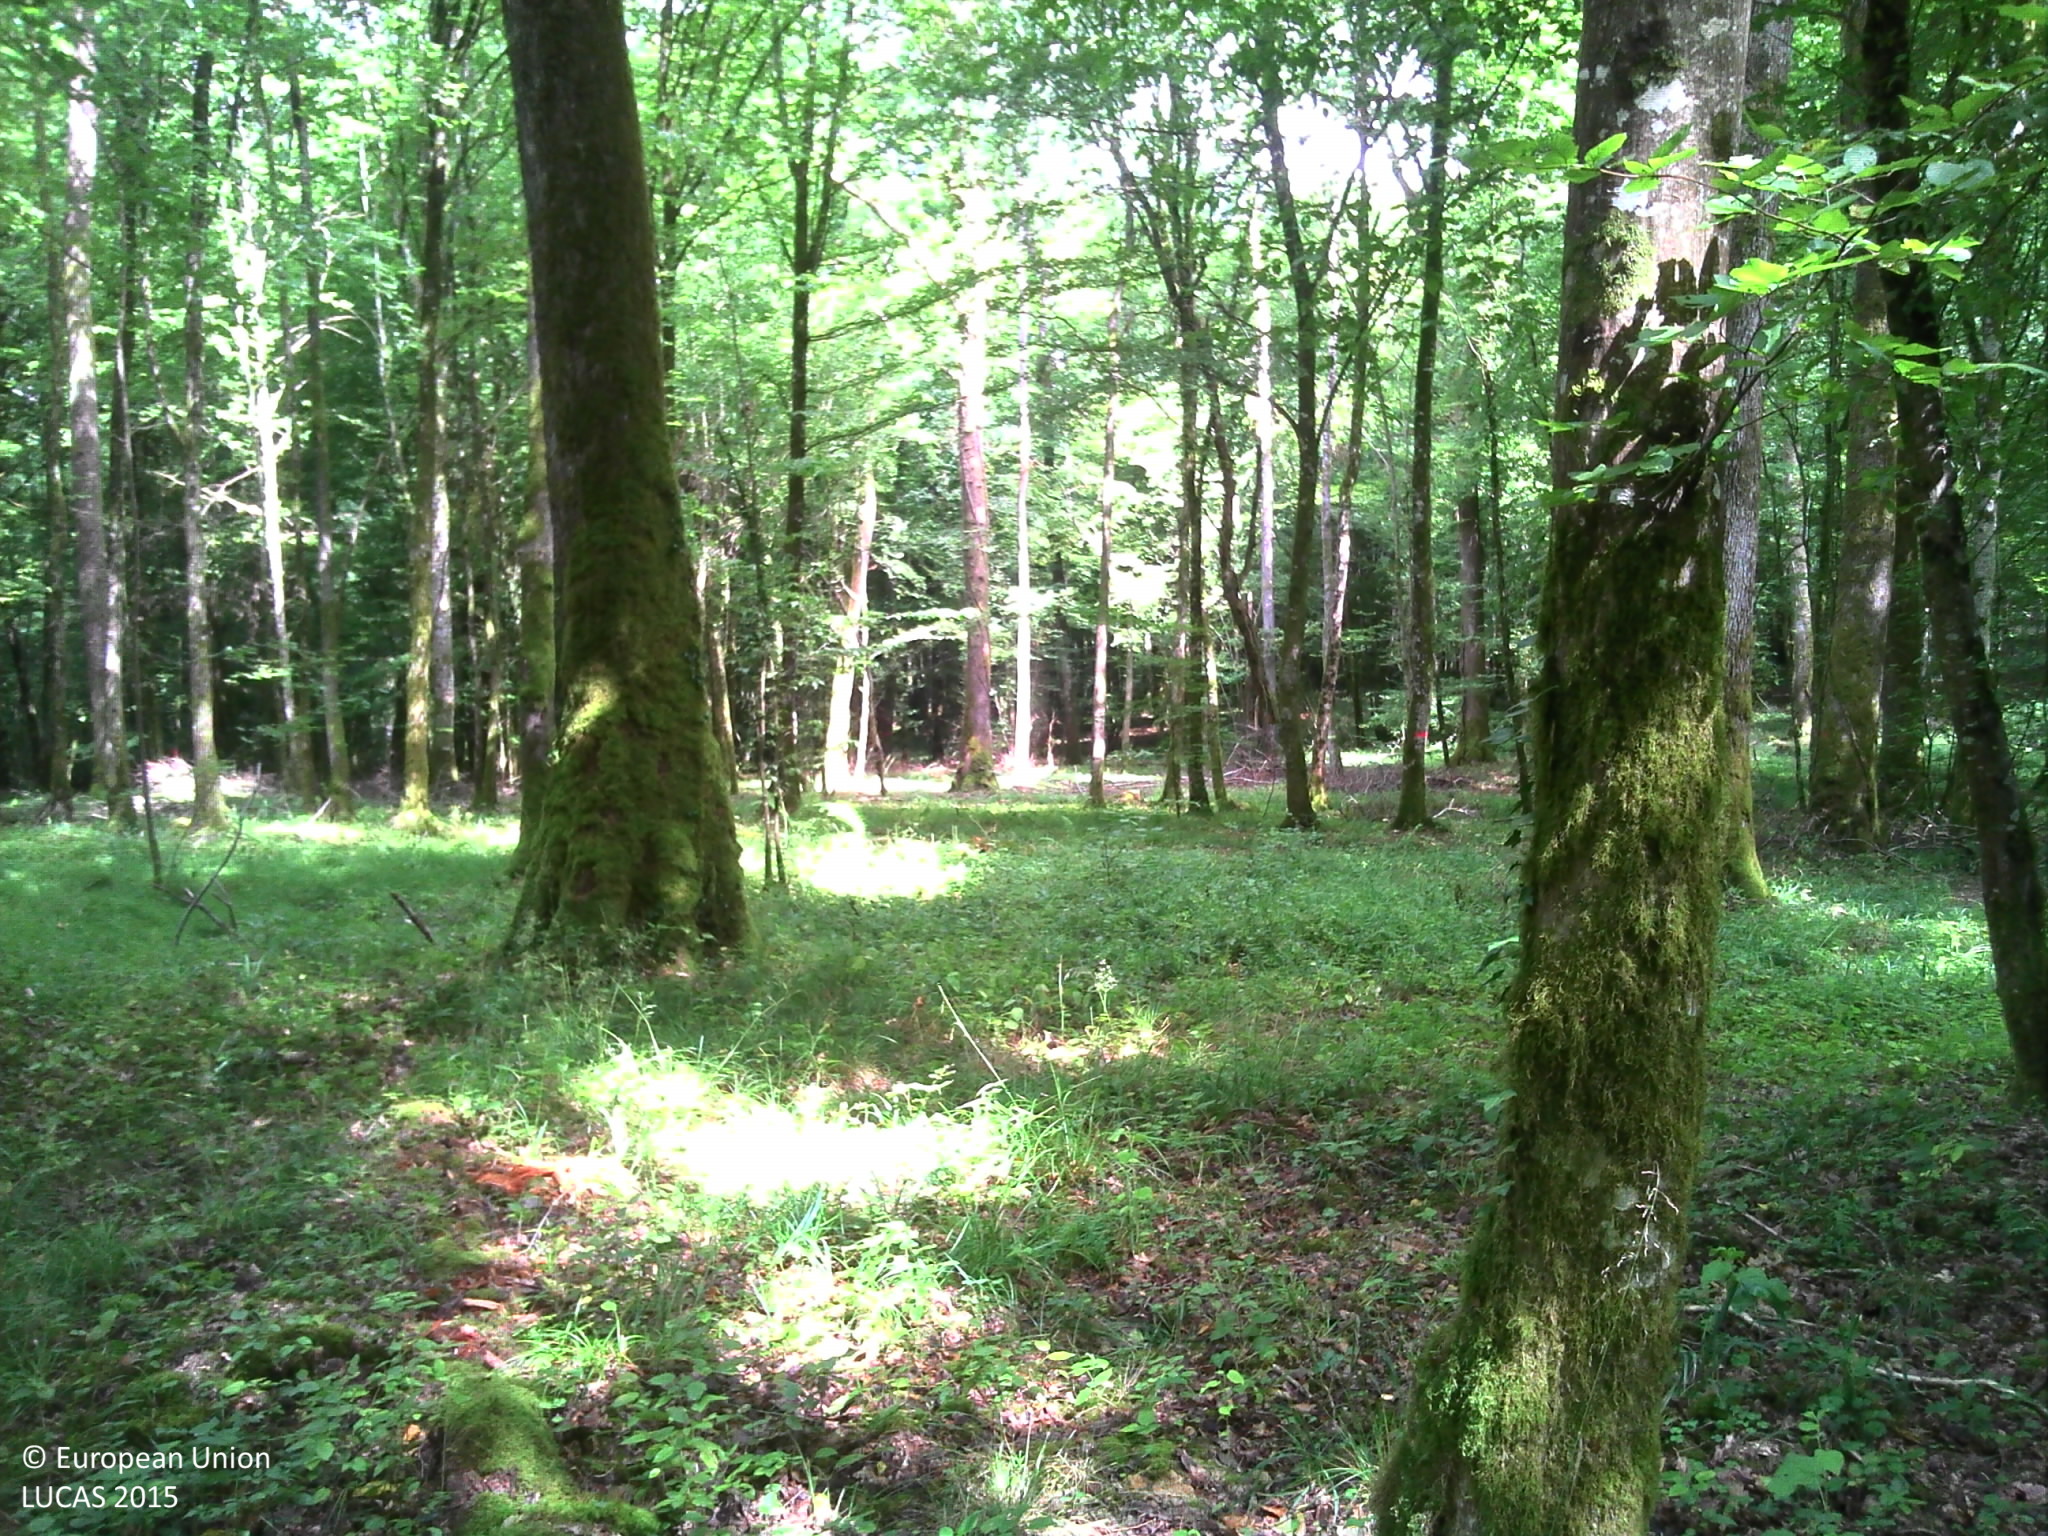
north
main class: Woodland
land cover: Broadleaved woodland
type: mesophytic deciduous forest
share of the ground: > 75 %
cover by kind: broadleaved forest trees 95 %, herbaceous plants 5 %
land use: Forestry
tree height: > 5 m
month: July
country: FR
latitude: 49.2140
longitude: 5.0971
